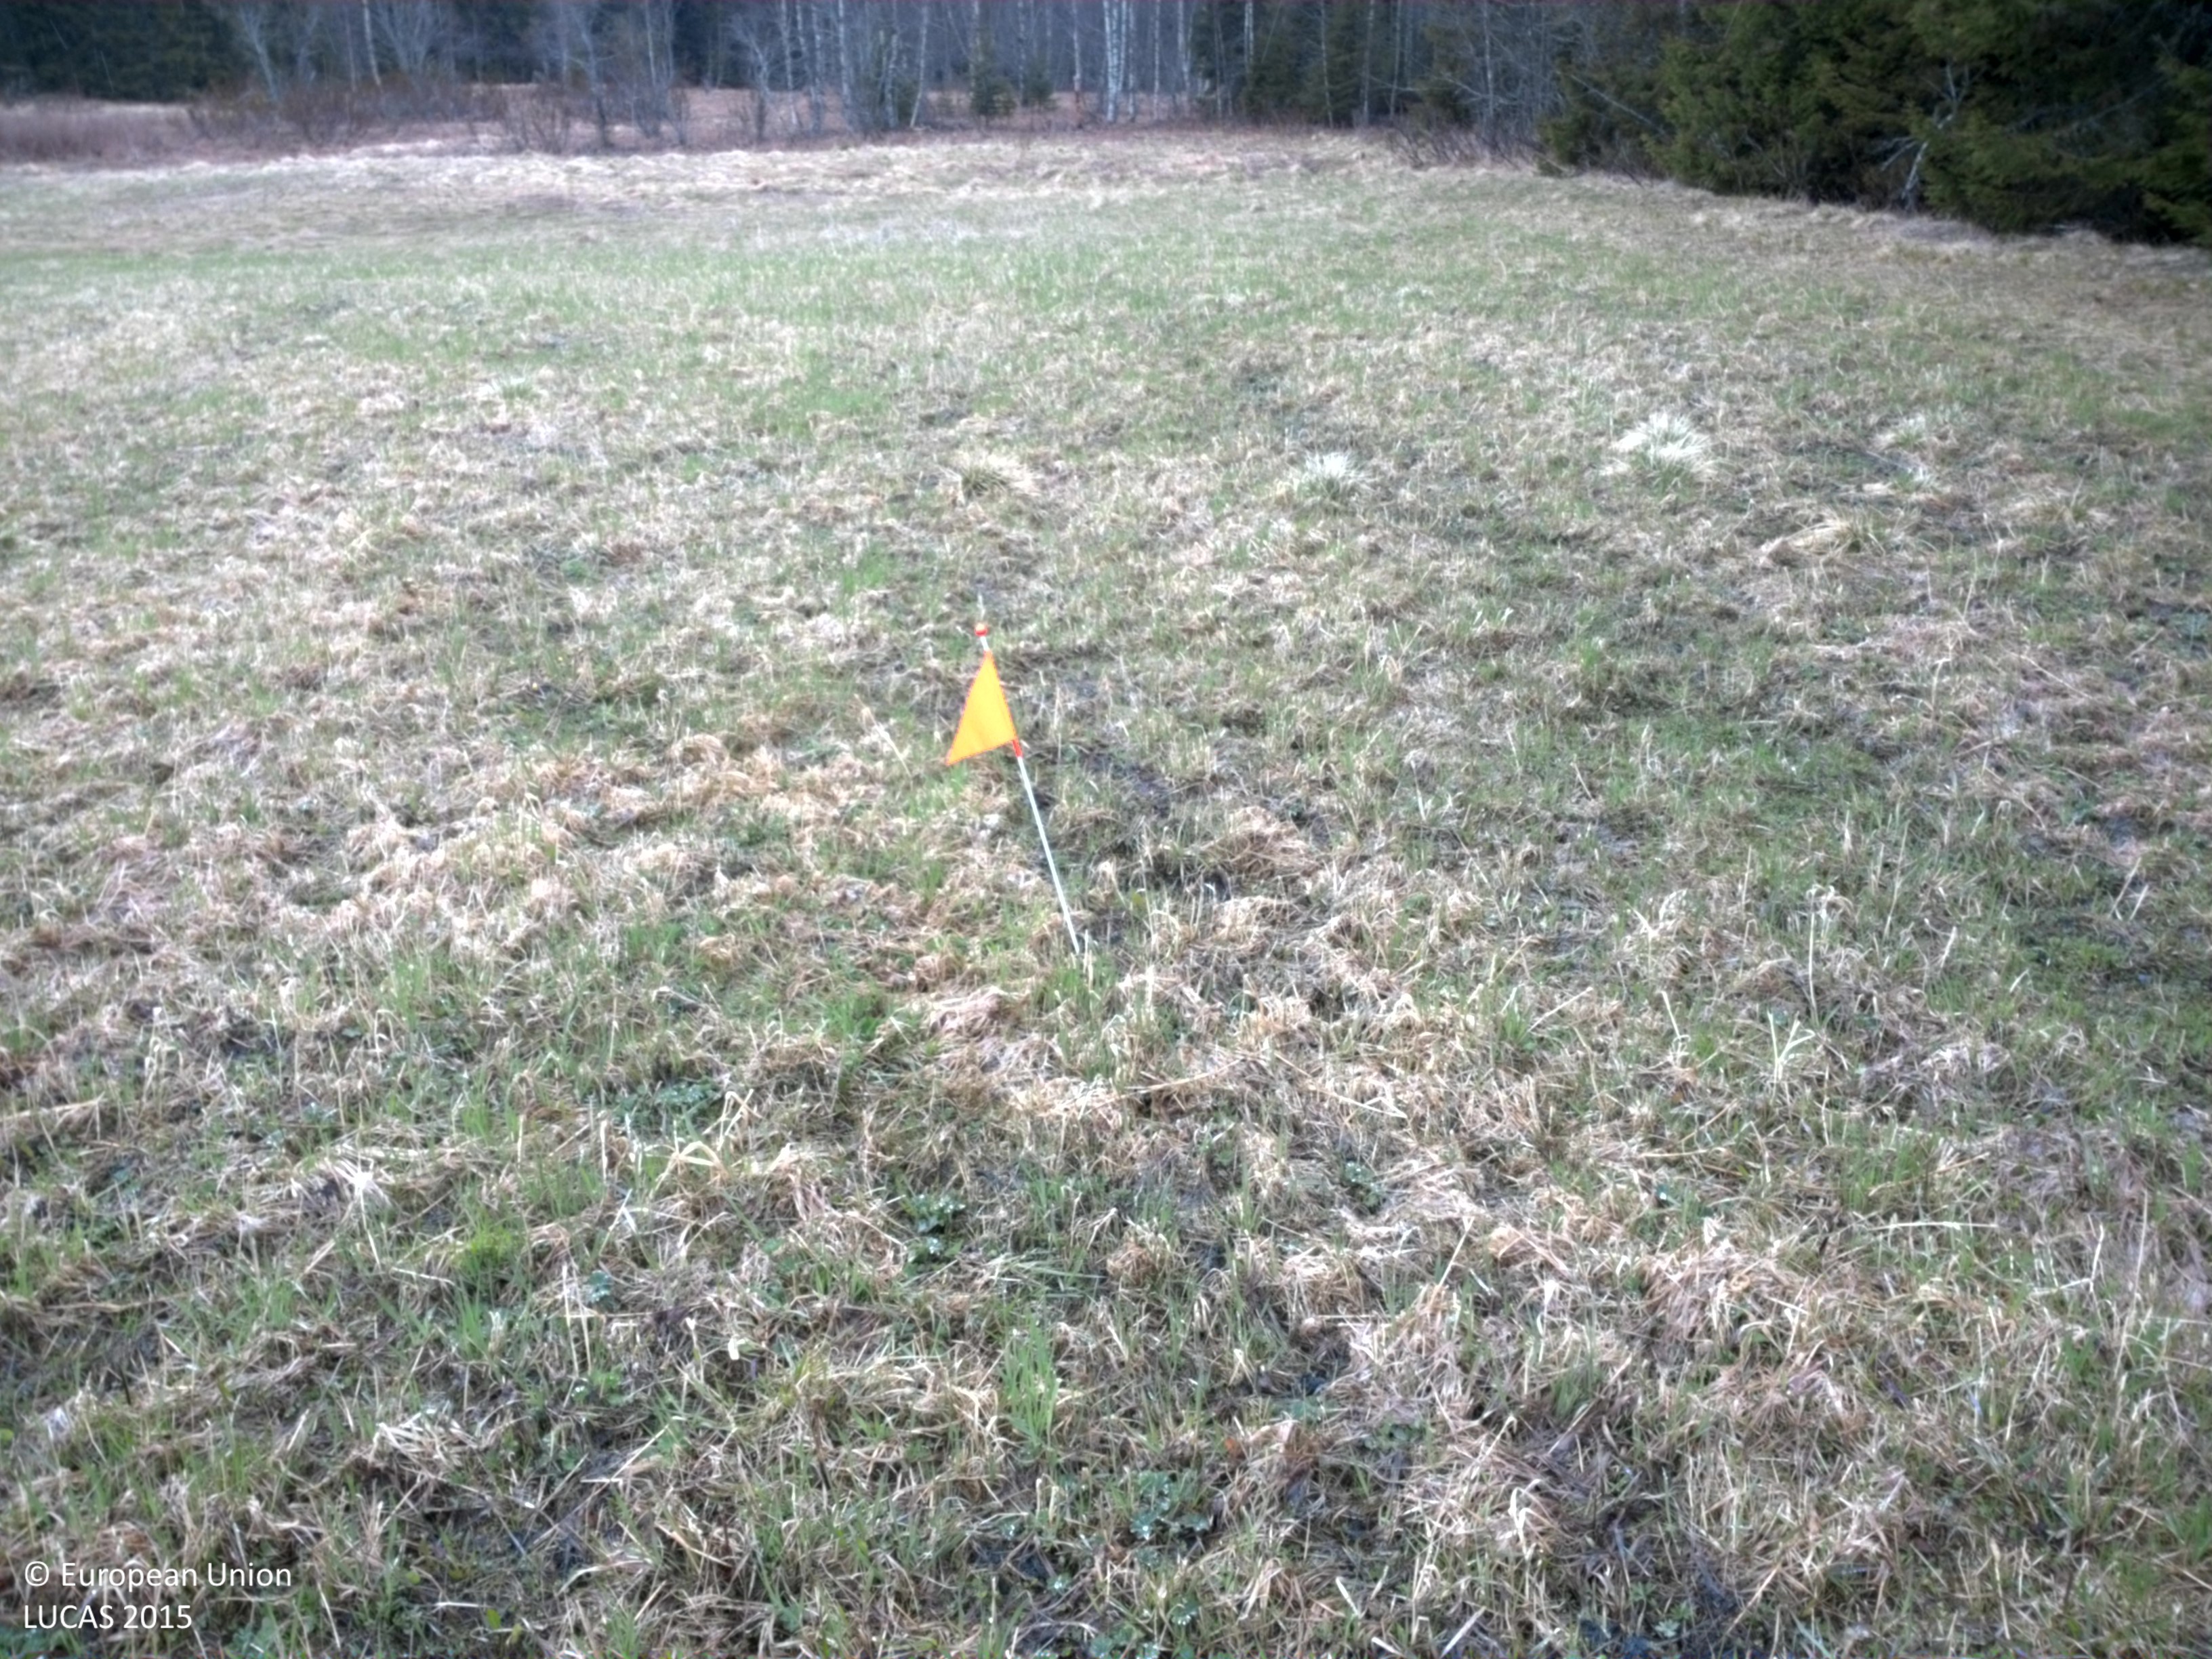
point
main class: Grassland
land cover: Grassland without tree/shrub cover
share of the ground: > 75 %
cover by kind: herbaceous plants 100 %
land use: Agriculture (excluding fallow land and kitchen gardens)
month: May
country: SE
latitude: 63.3948
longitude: 13.8035
